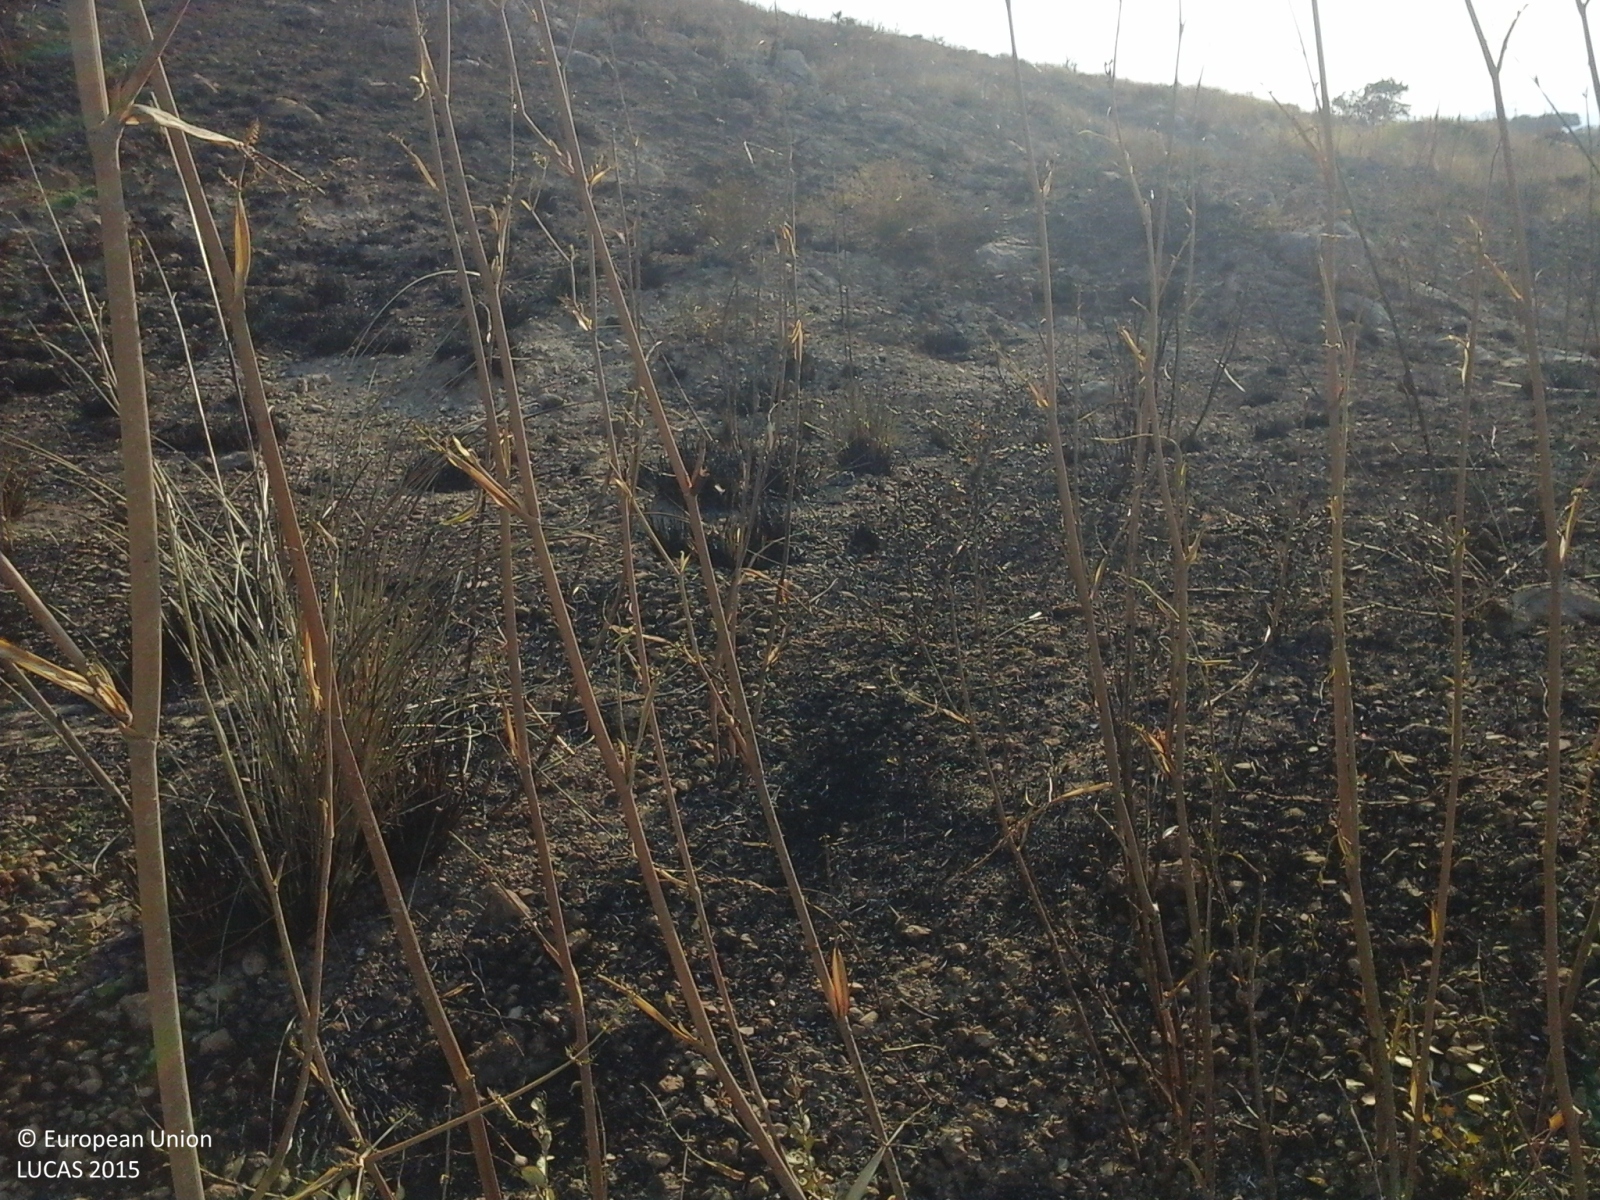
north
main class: Grassland
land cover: Grassland without tree/shrub cover
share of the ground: > 75 %
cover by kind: herbaceous plants 100 %
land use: Semi-natural and natural areas not in use
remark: Burnt area
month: July
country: IT
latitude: 37.2437
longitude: 14.0382
